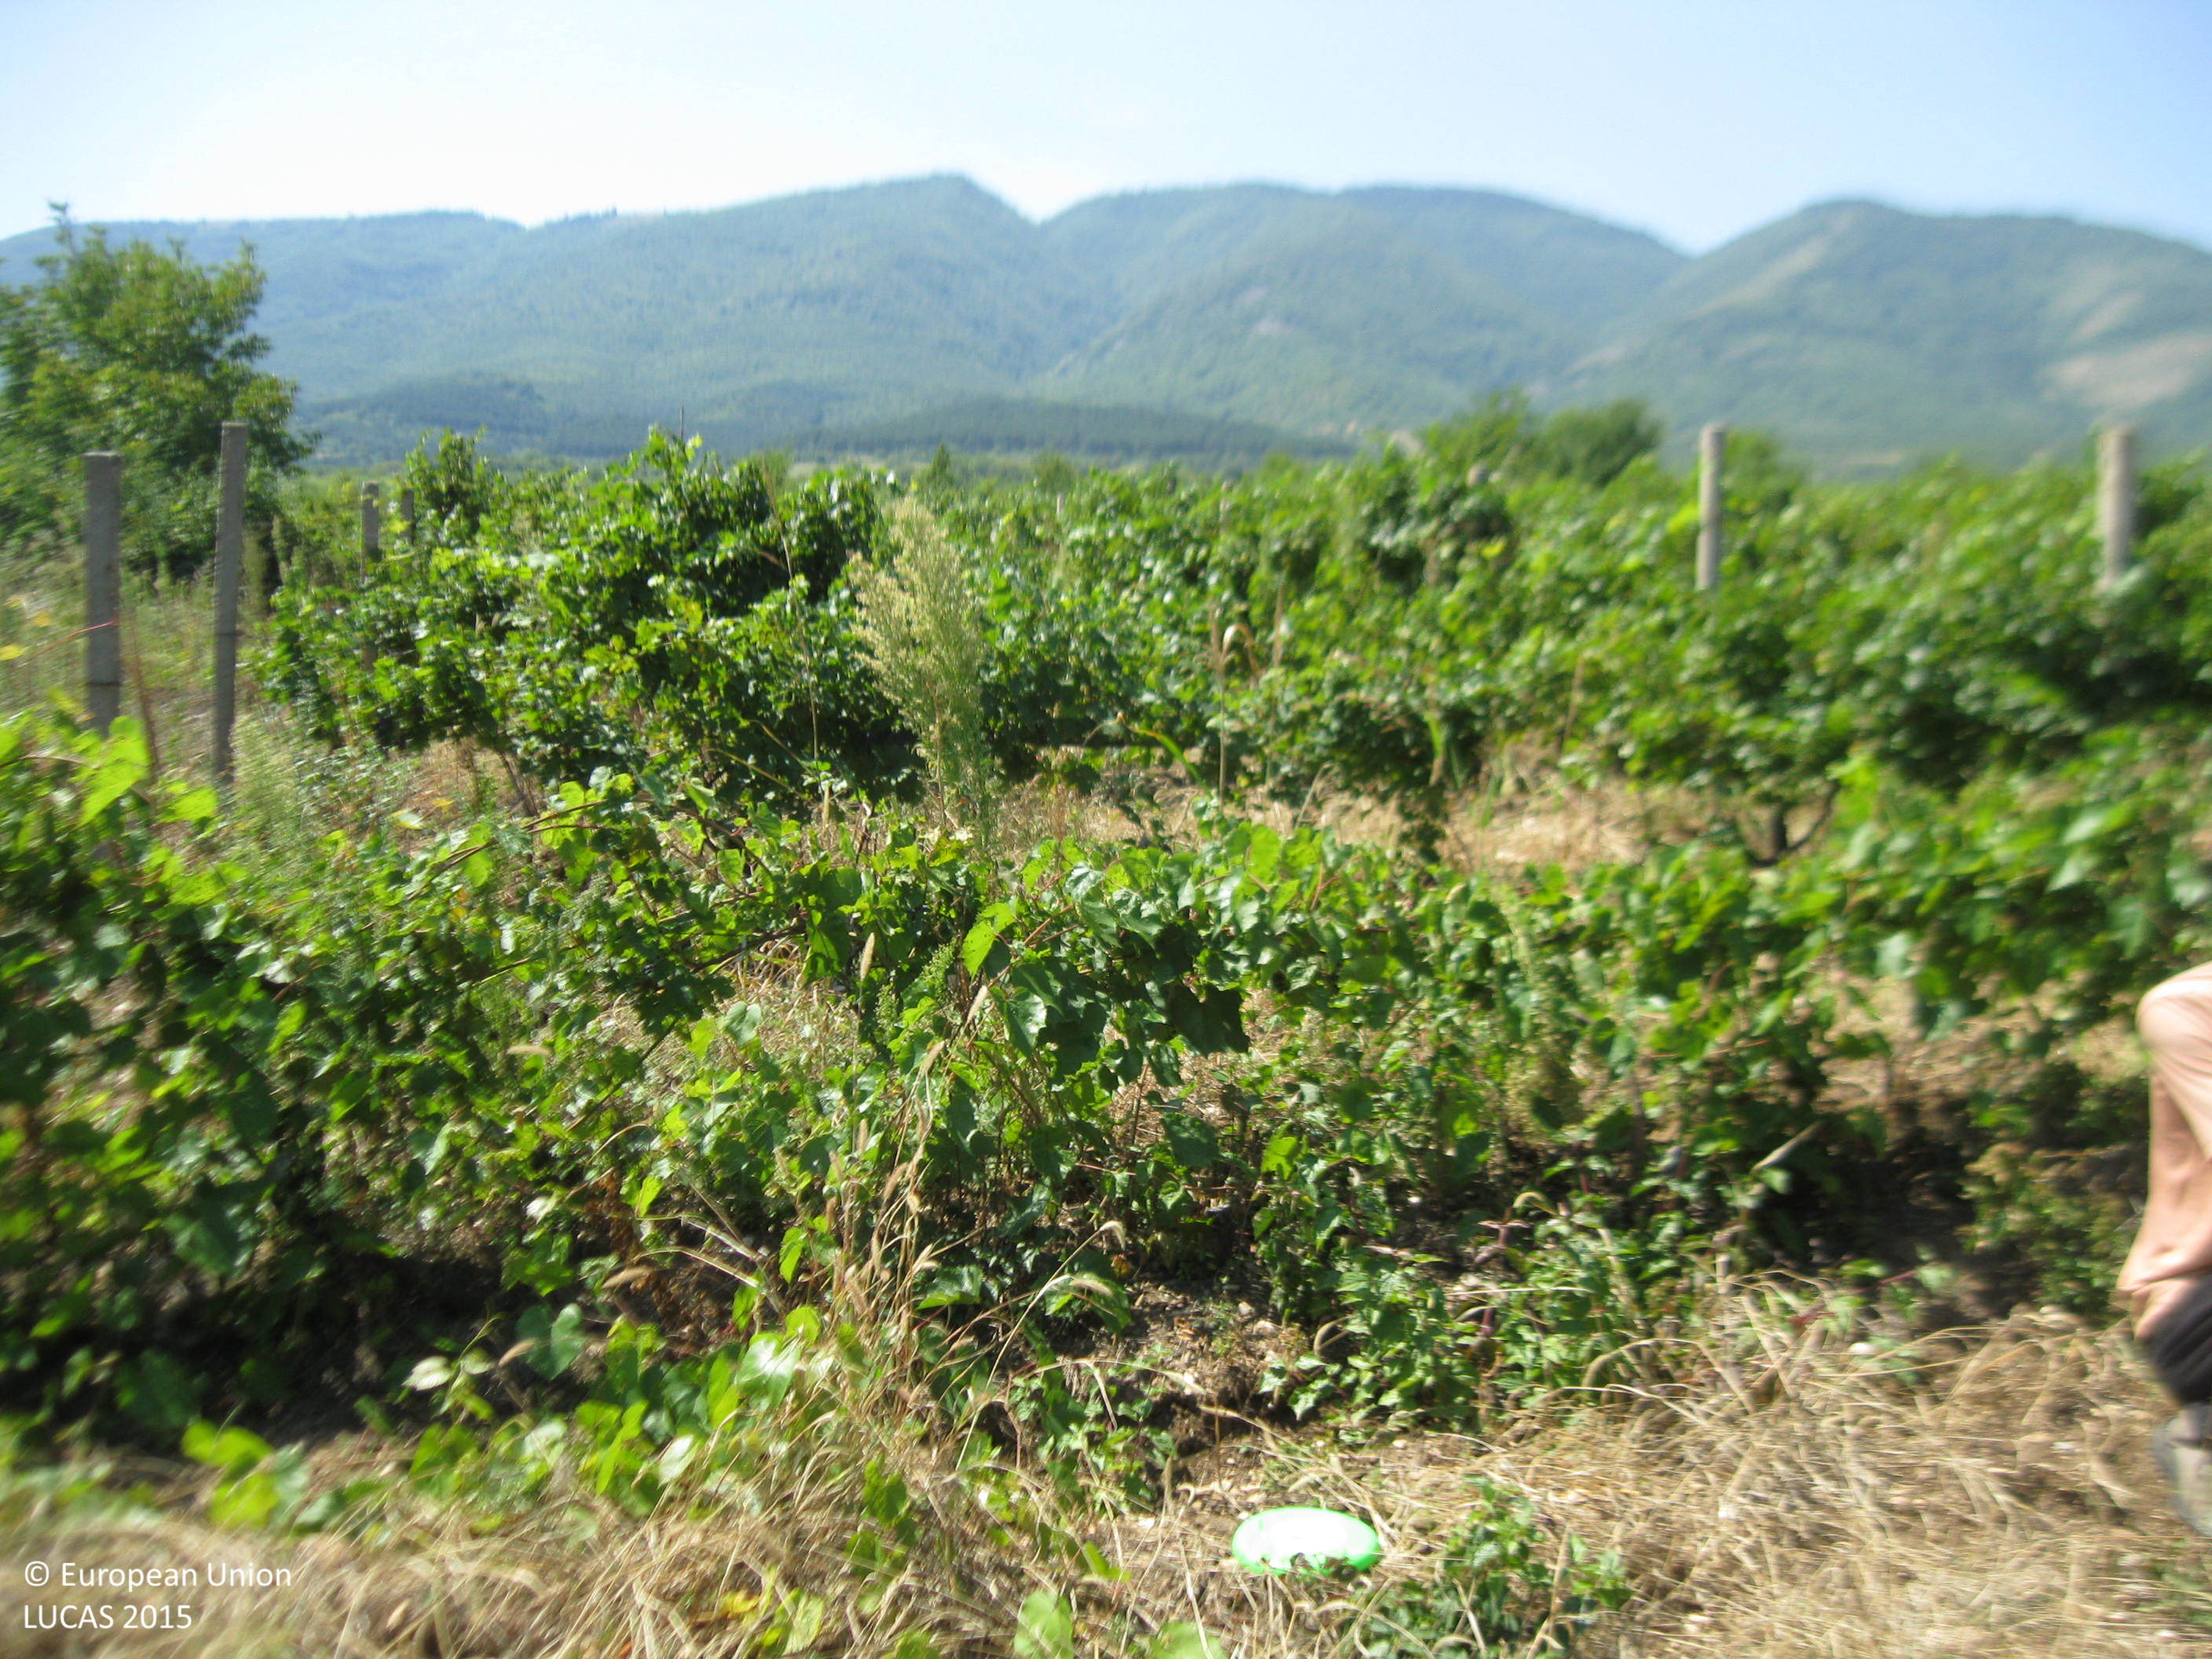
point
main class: Cropland
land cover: Vineyards
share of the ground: 25 - 50 %
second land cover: Spontaneously vegetated surfaces
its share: 50 - 75 %
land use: Agriculture (excluding fallow land and kitchen gardens)
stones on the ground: 10 - 25 %
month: August
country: BG
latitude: 41.9373
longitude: 24.9724
